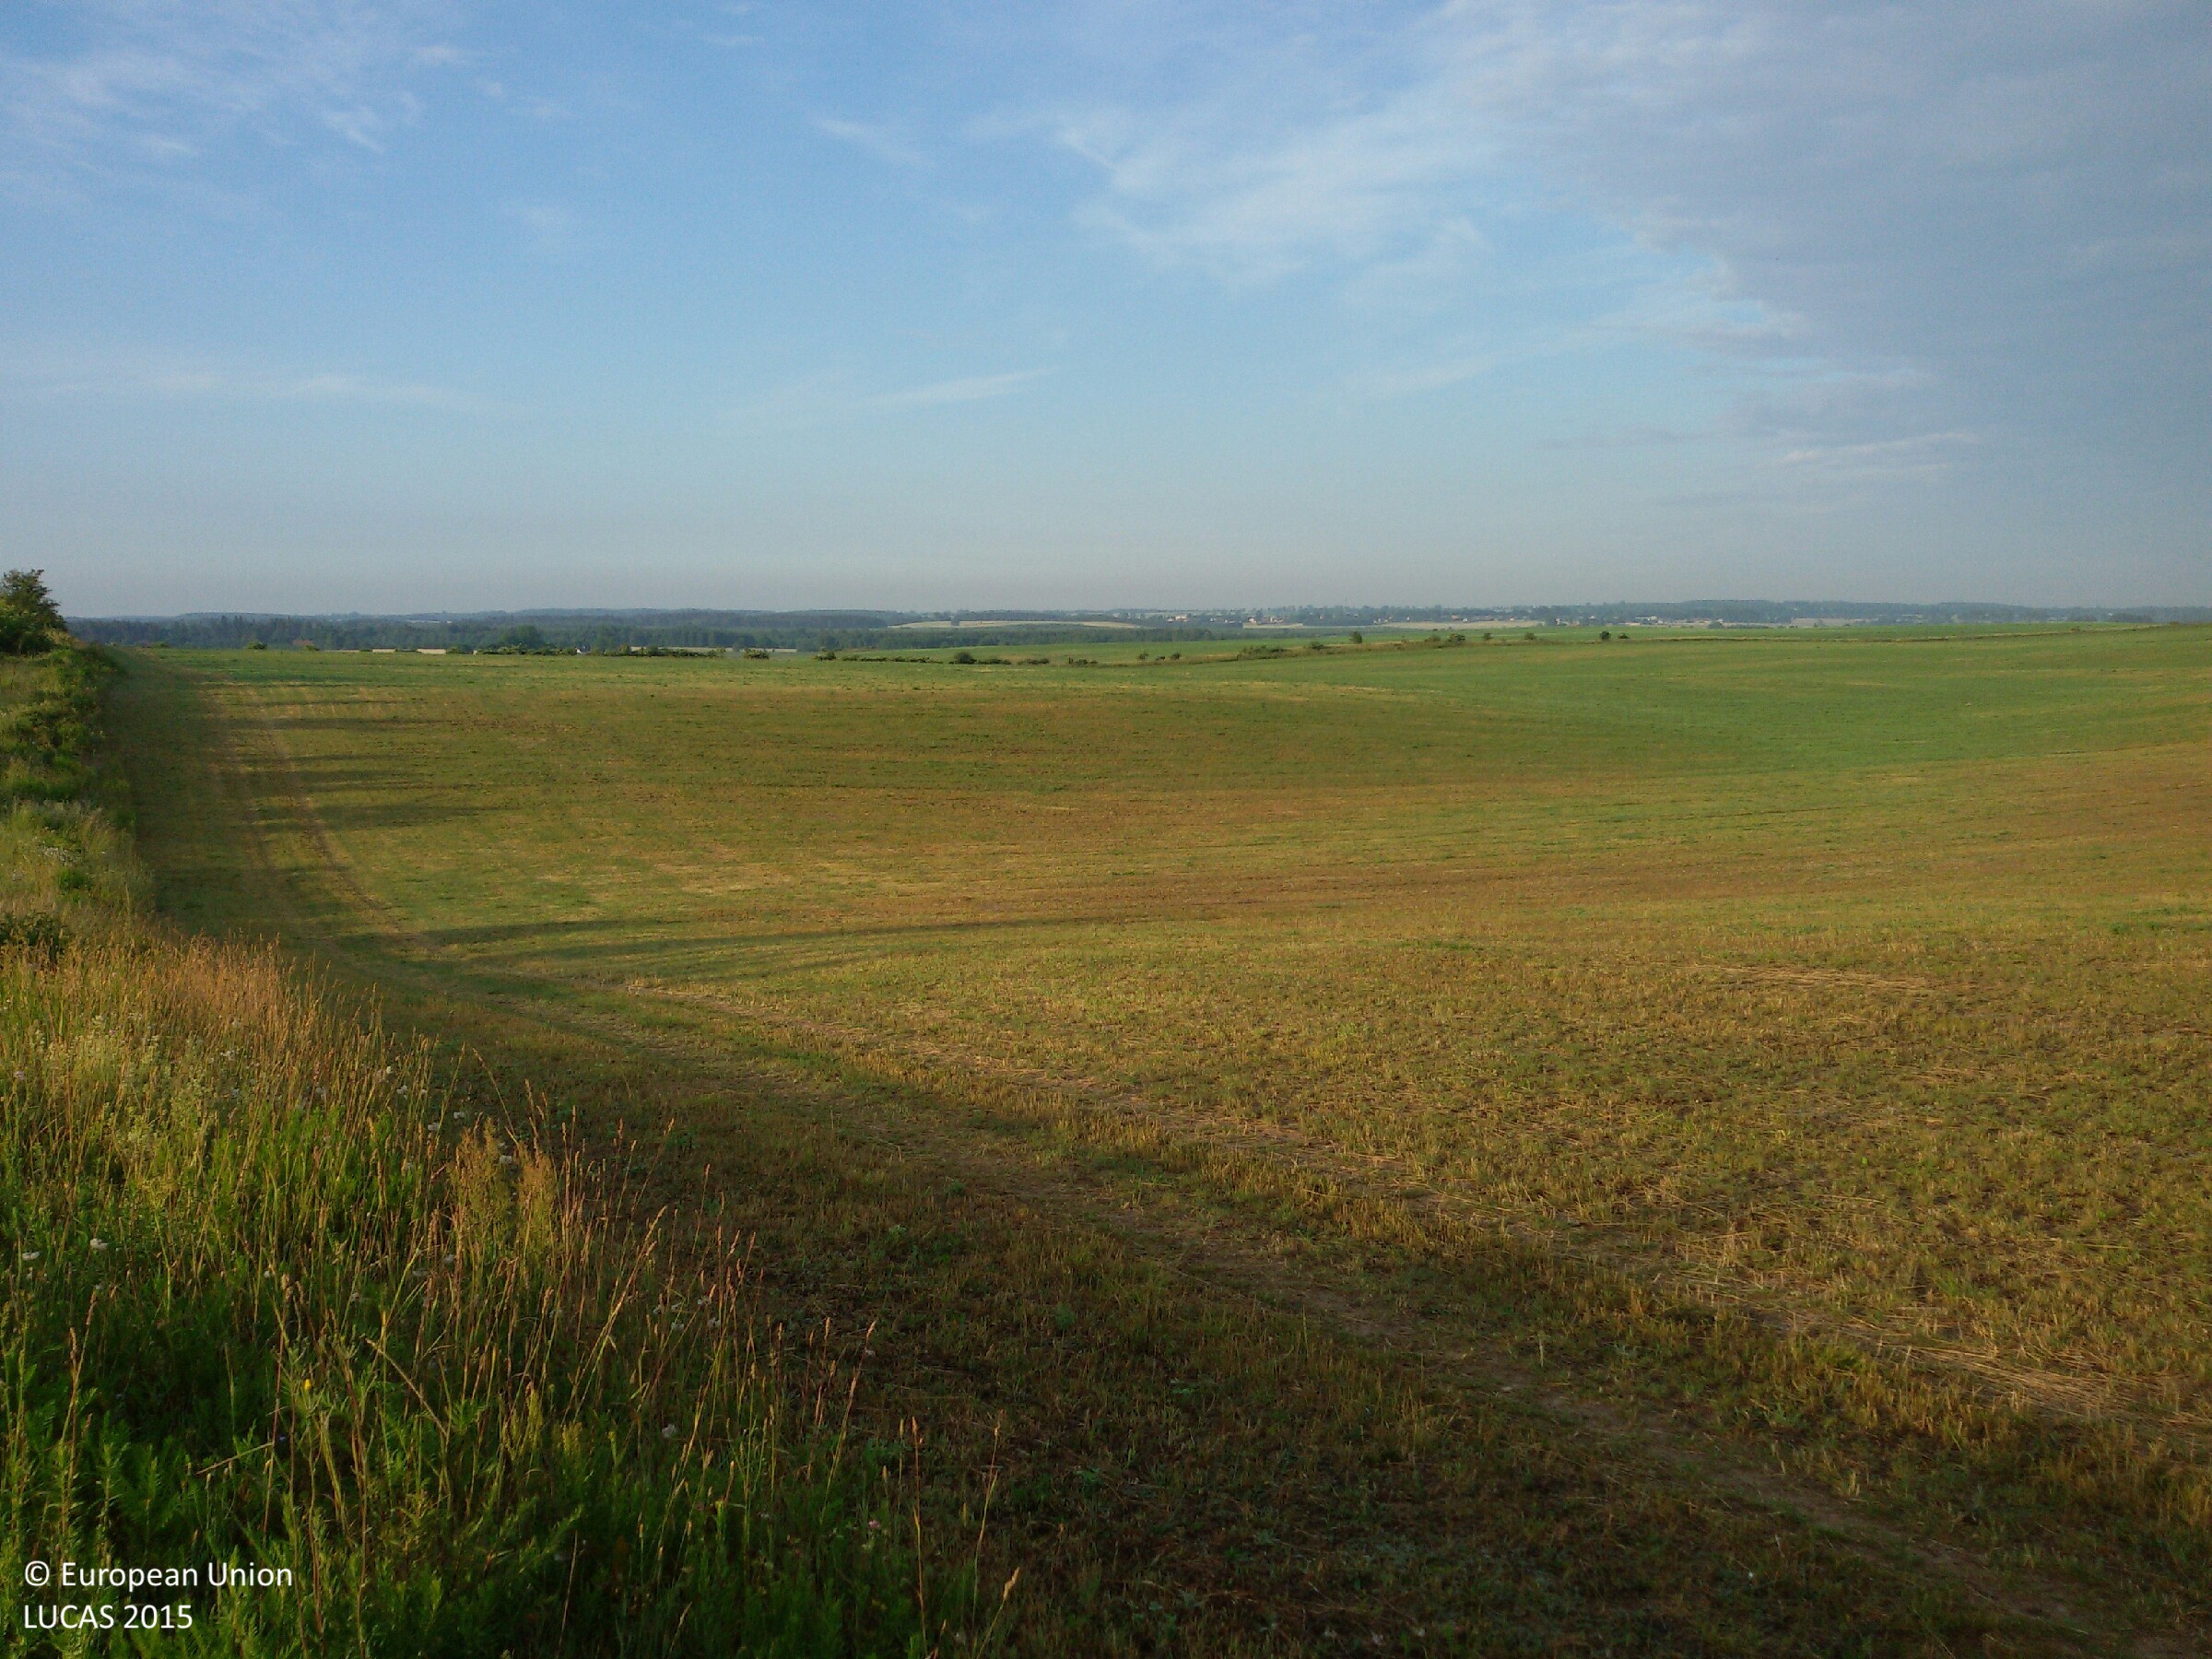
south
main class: Grassland
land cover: Grassland without tree/shrub cover
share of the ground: > 75 %
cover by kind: herbaceous plants 95 %, unconsolidated bare surface 5 %
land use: Air transport
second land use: Agriculture (excluding fallow land and kitchen gardens)
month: June
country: PL
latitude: 53.5356
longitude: 20.1575
